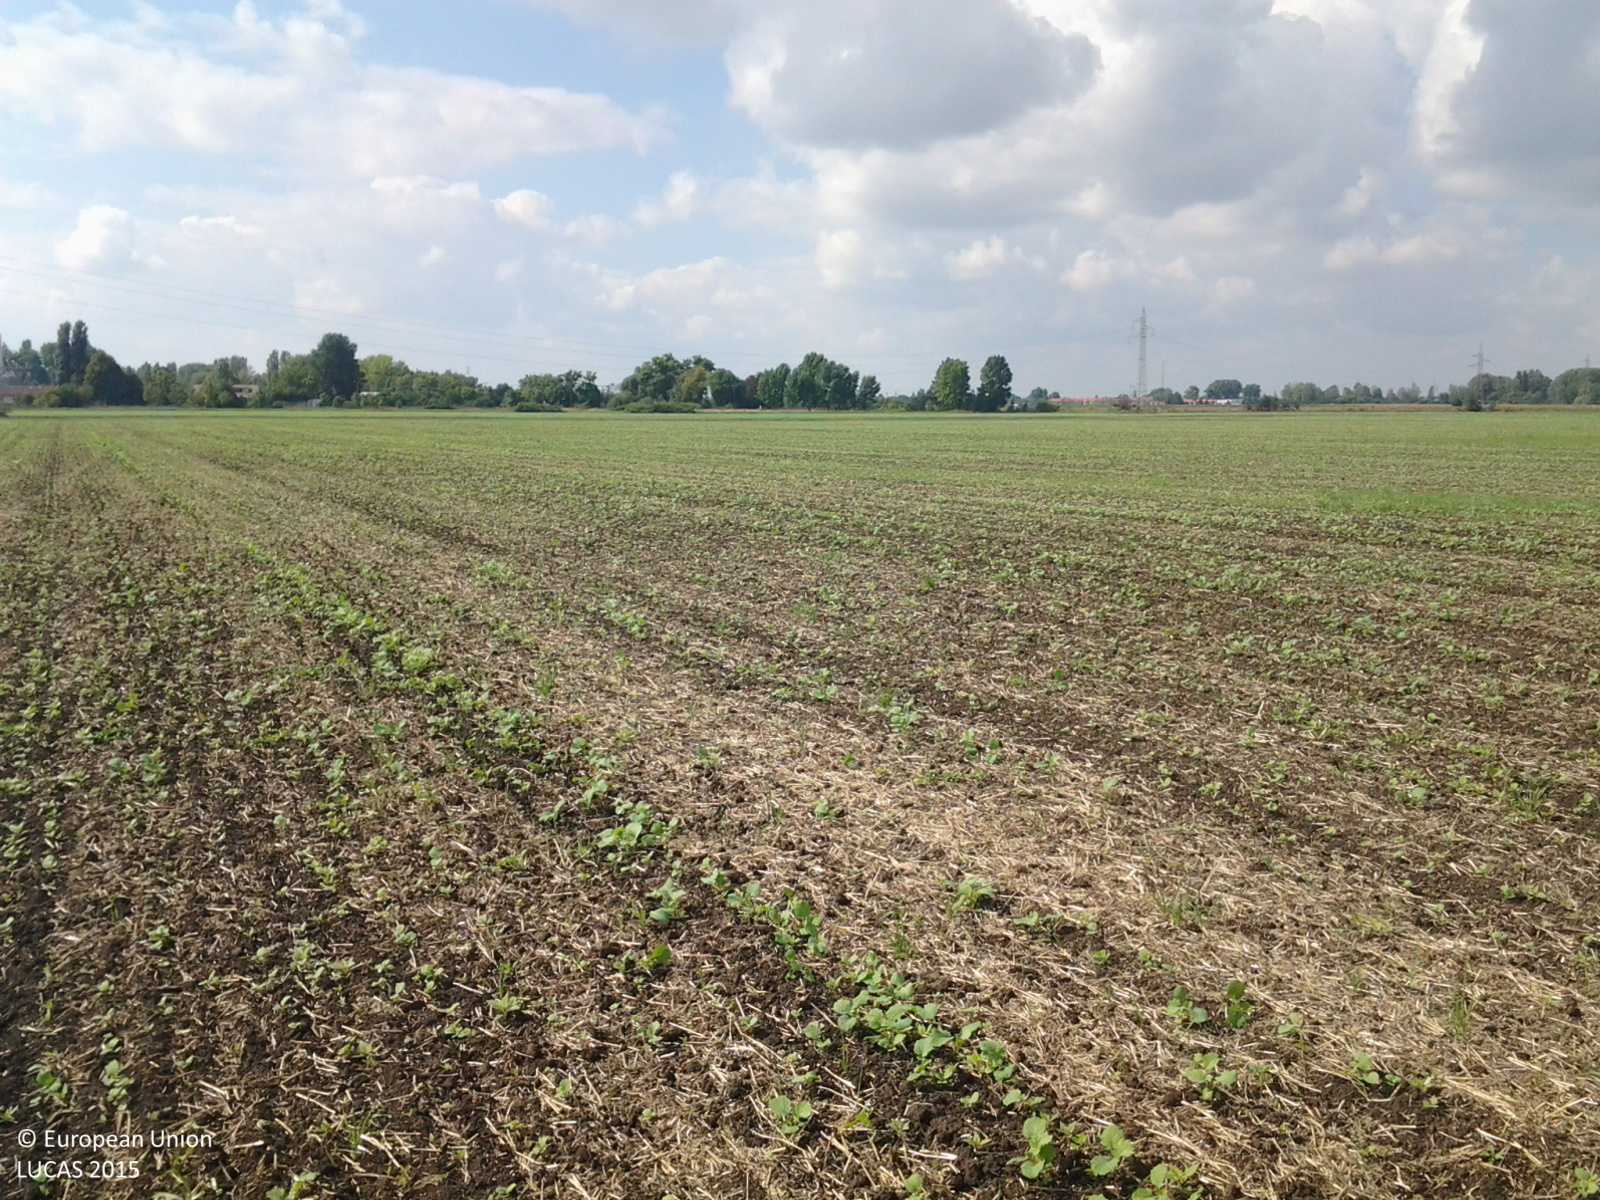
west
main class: Cropland
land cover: Rape and turnip rape
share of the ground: 25 - 50 %
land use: Agriculture (excluding fallow land and kitchen gardens)
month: September
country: HU
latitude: 47.6116
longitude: 20.3130
